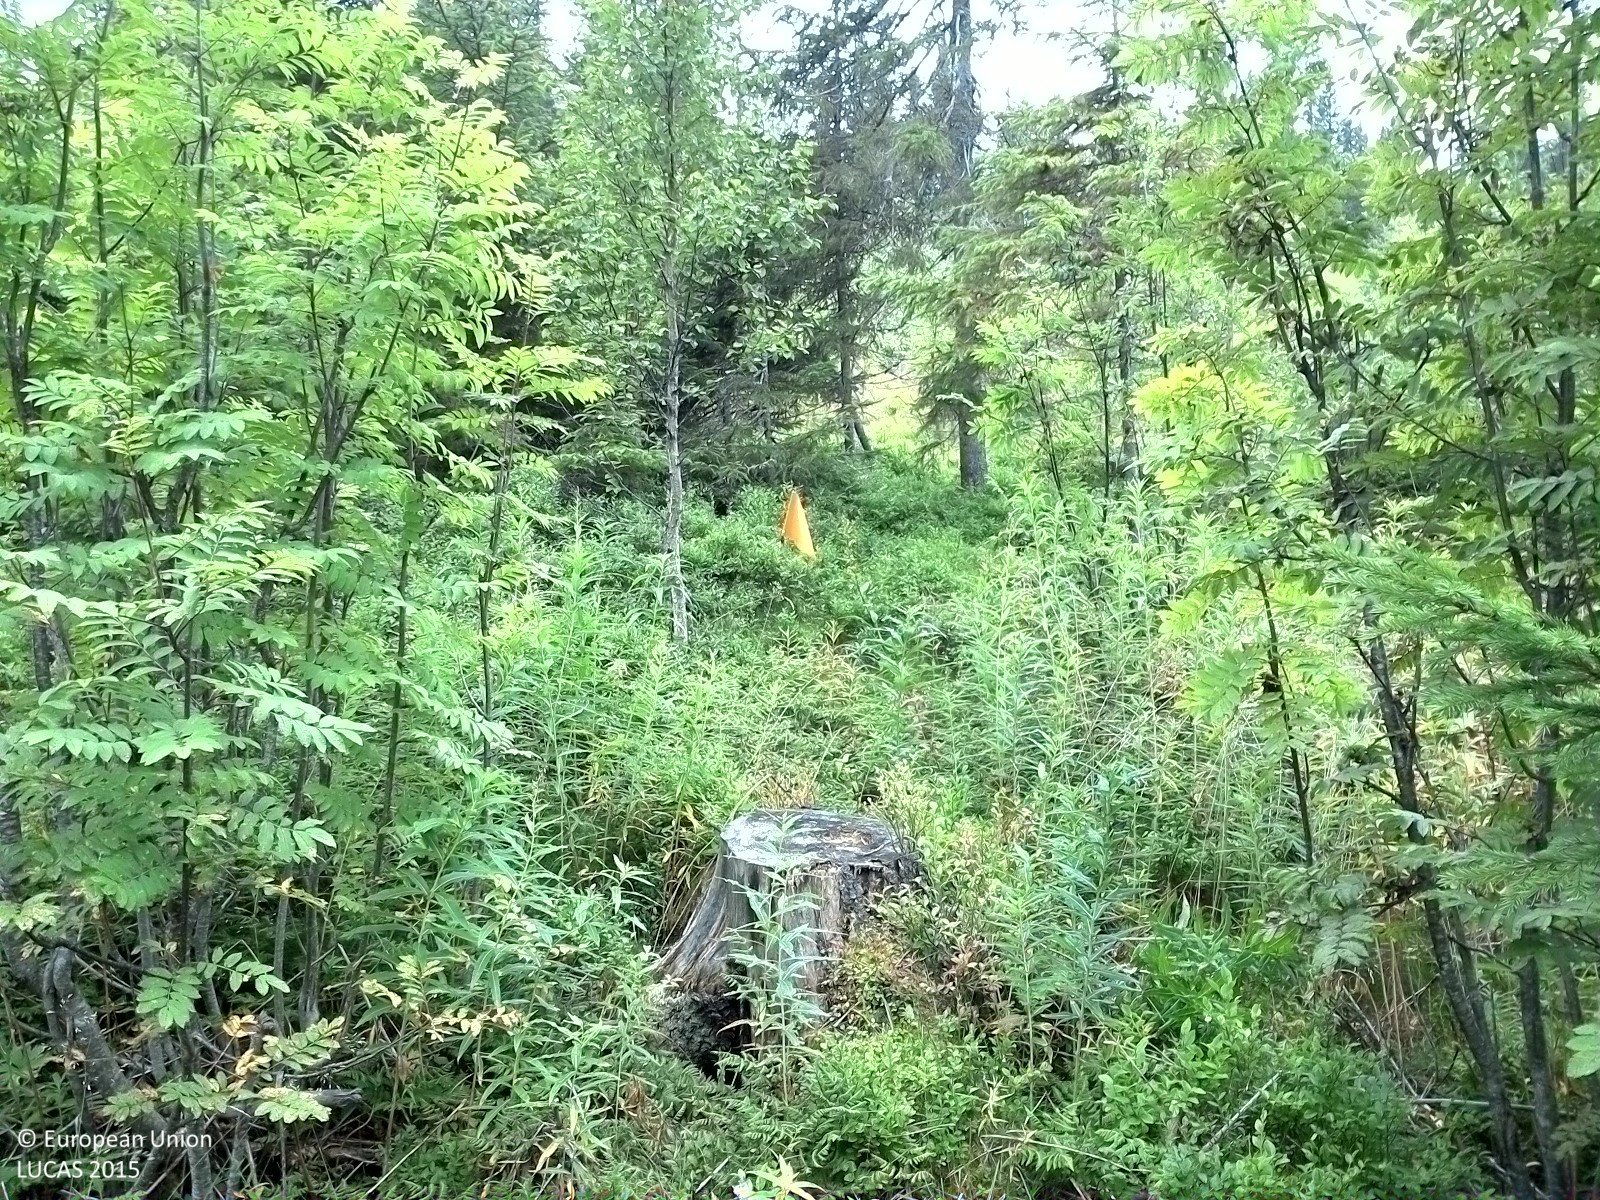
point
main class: Woodland
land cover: Spruce dominated mixed woodland
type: boreal forest
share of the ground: 25 - 50 %
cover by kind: herbaceous plants 30 %, coniferous forest trees 25 %, broadleaved forest trees 25 %, shrubs 20 %
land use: Forestry
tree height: > 5 m
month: August
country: SE
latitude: 62.2839
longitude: 16.2441
